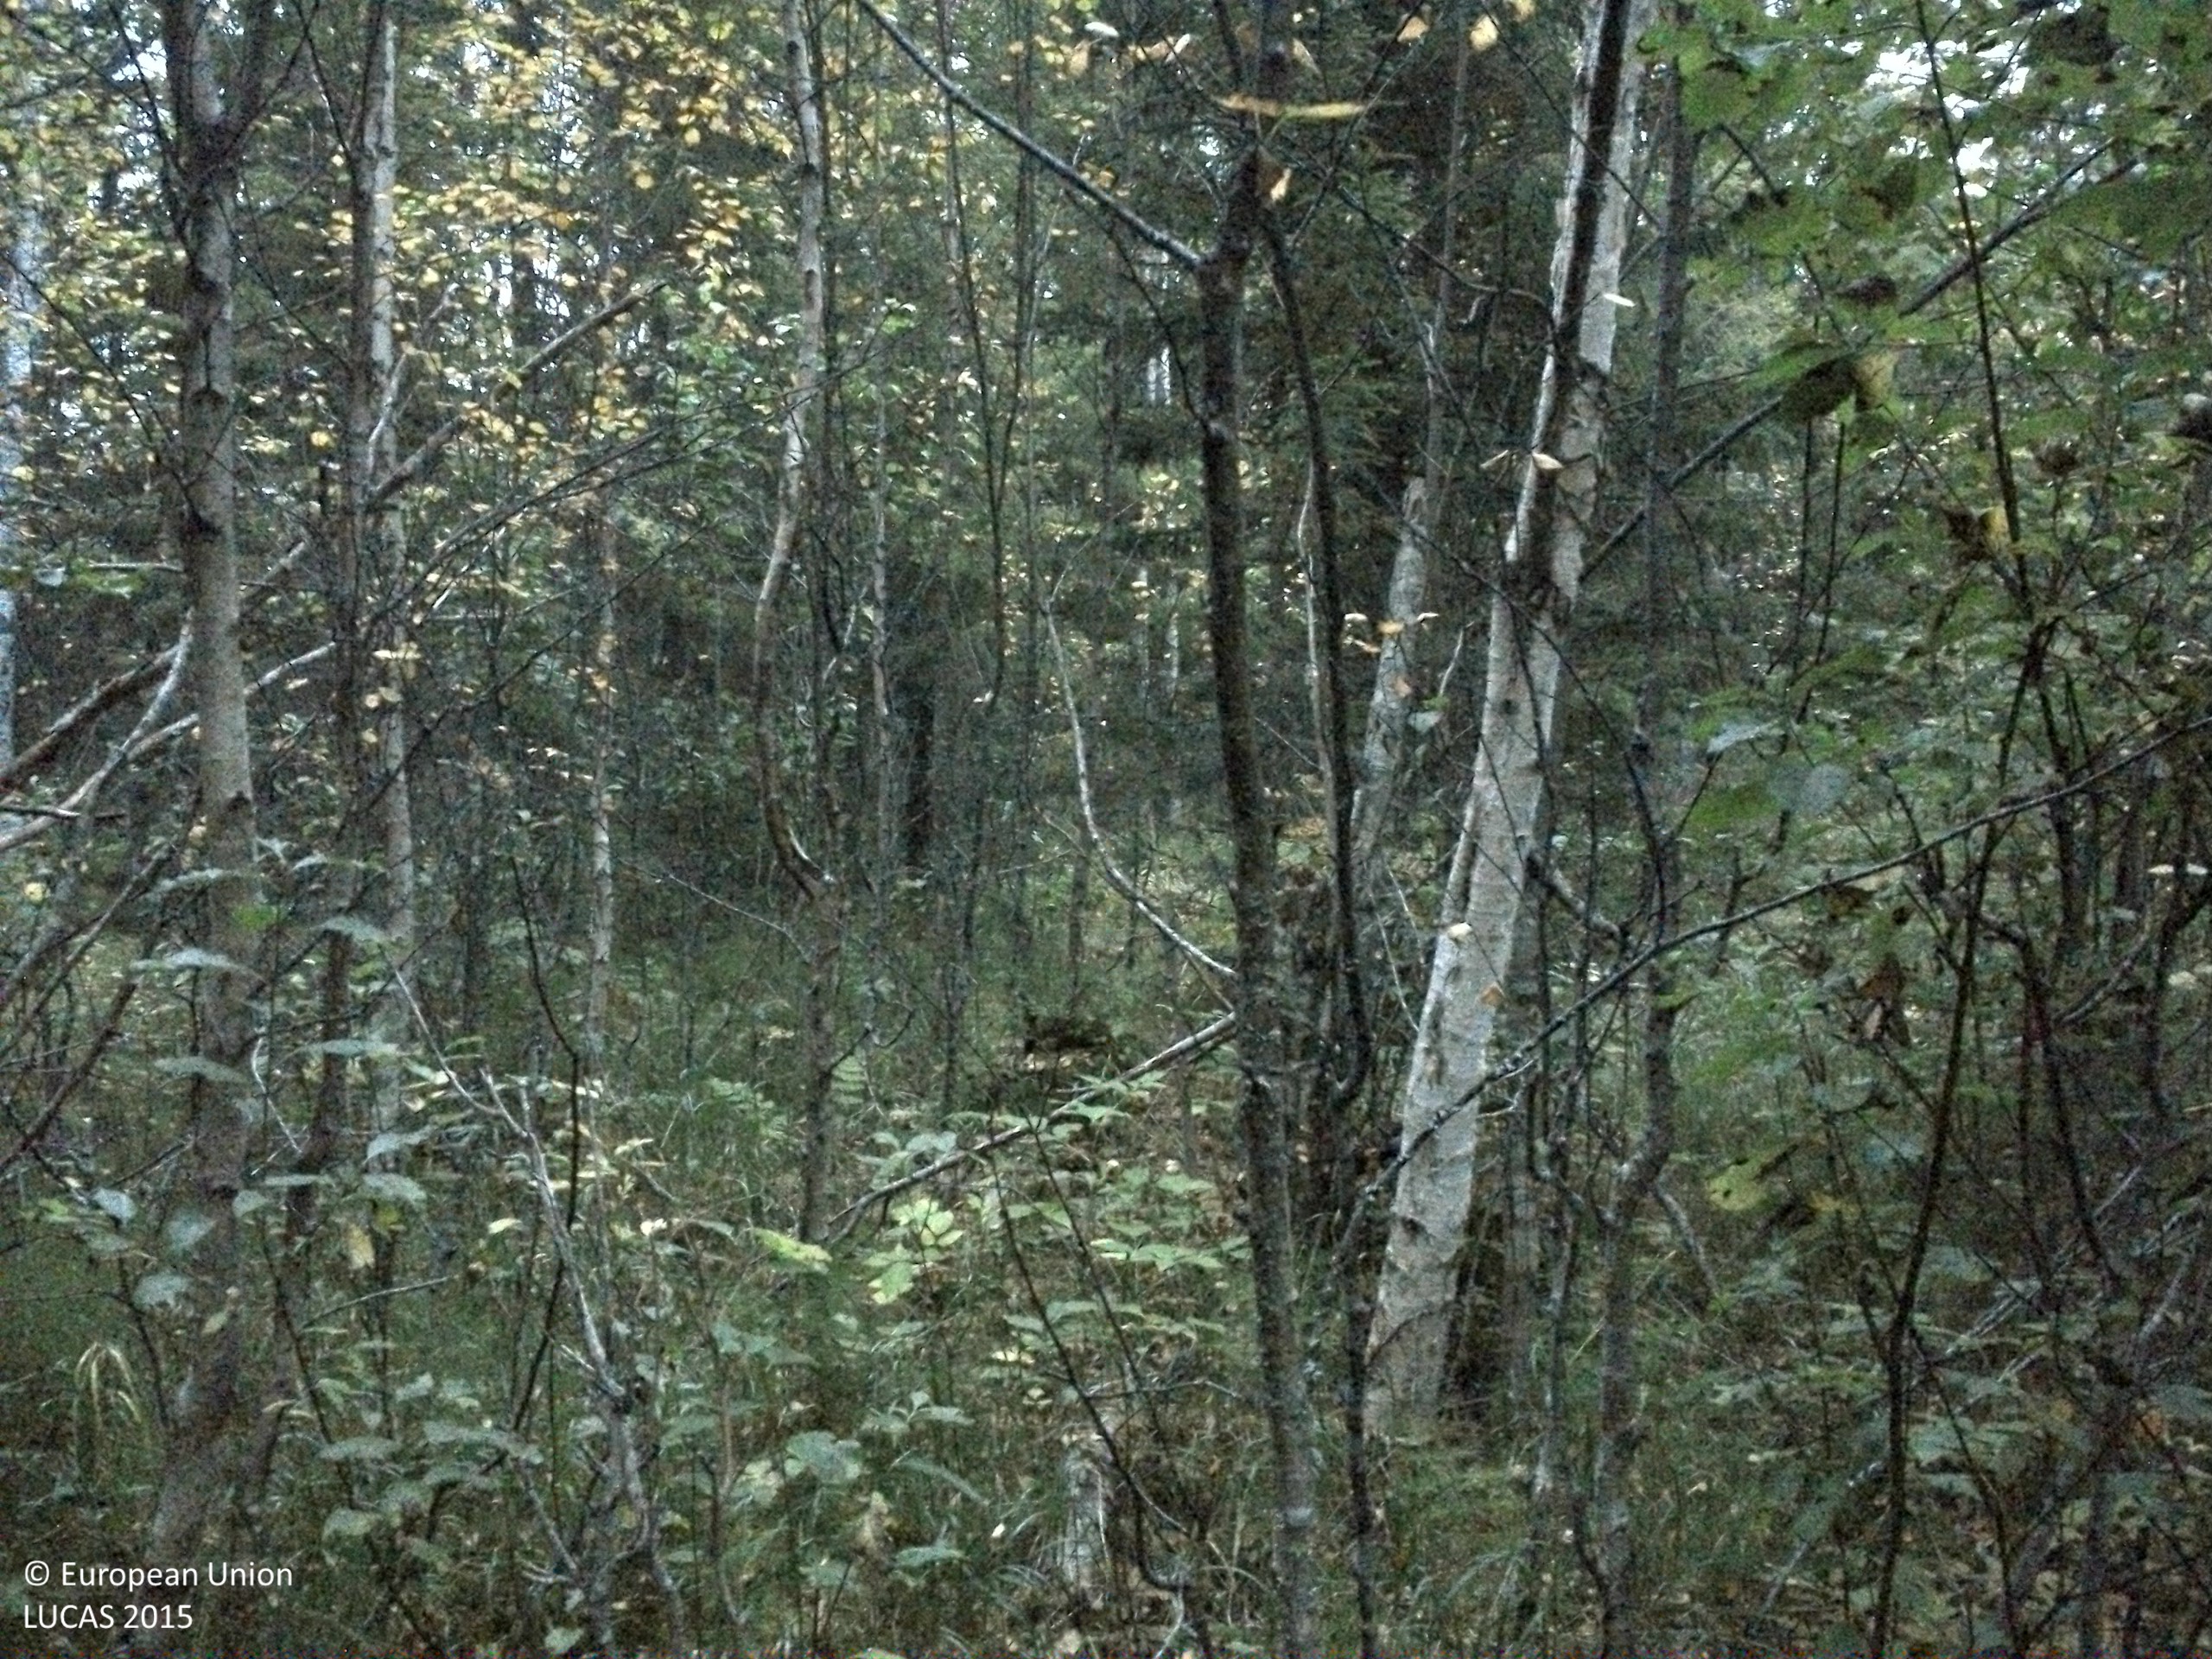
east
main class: Woodland
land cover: Spruce dominated mixed woodland
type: boreal forest
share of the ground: > 75 %
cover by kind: coniferous forest trees 50 %, broadleaved forest trees 25 %, shrubs 10 %, herbaceous plants 10 %, lichens and mosses 5 %
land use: Forestry
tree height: > 5 m
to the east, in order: Spruce dominated mixed woodland
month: September
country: SE
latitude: 63.6161
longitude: 15.9641
